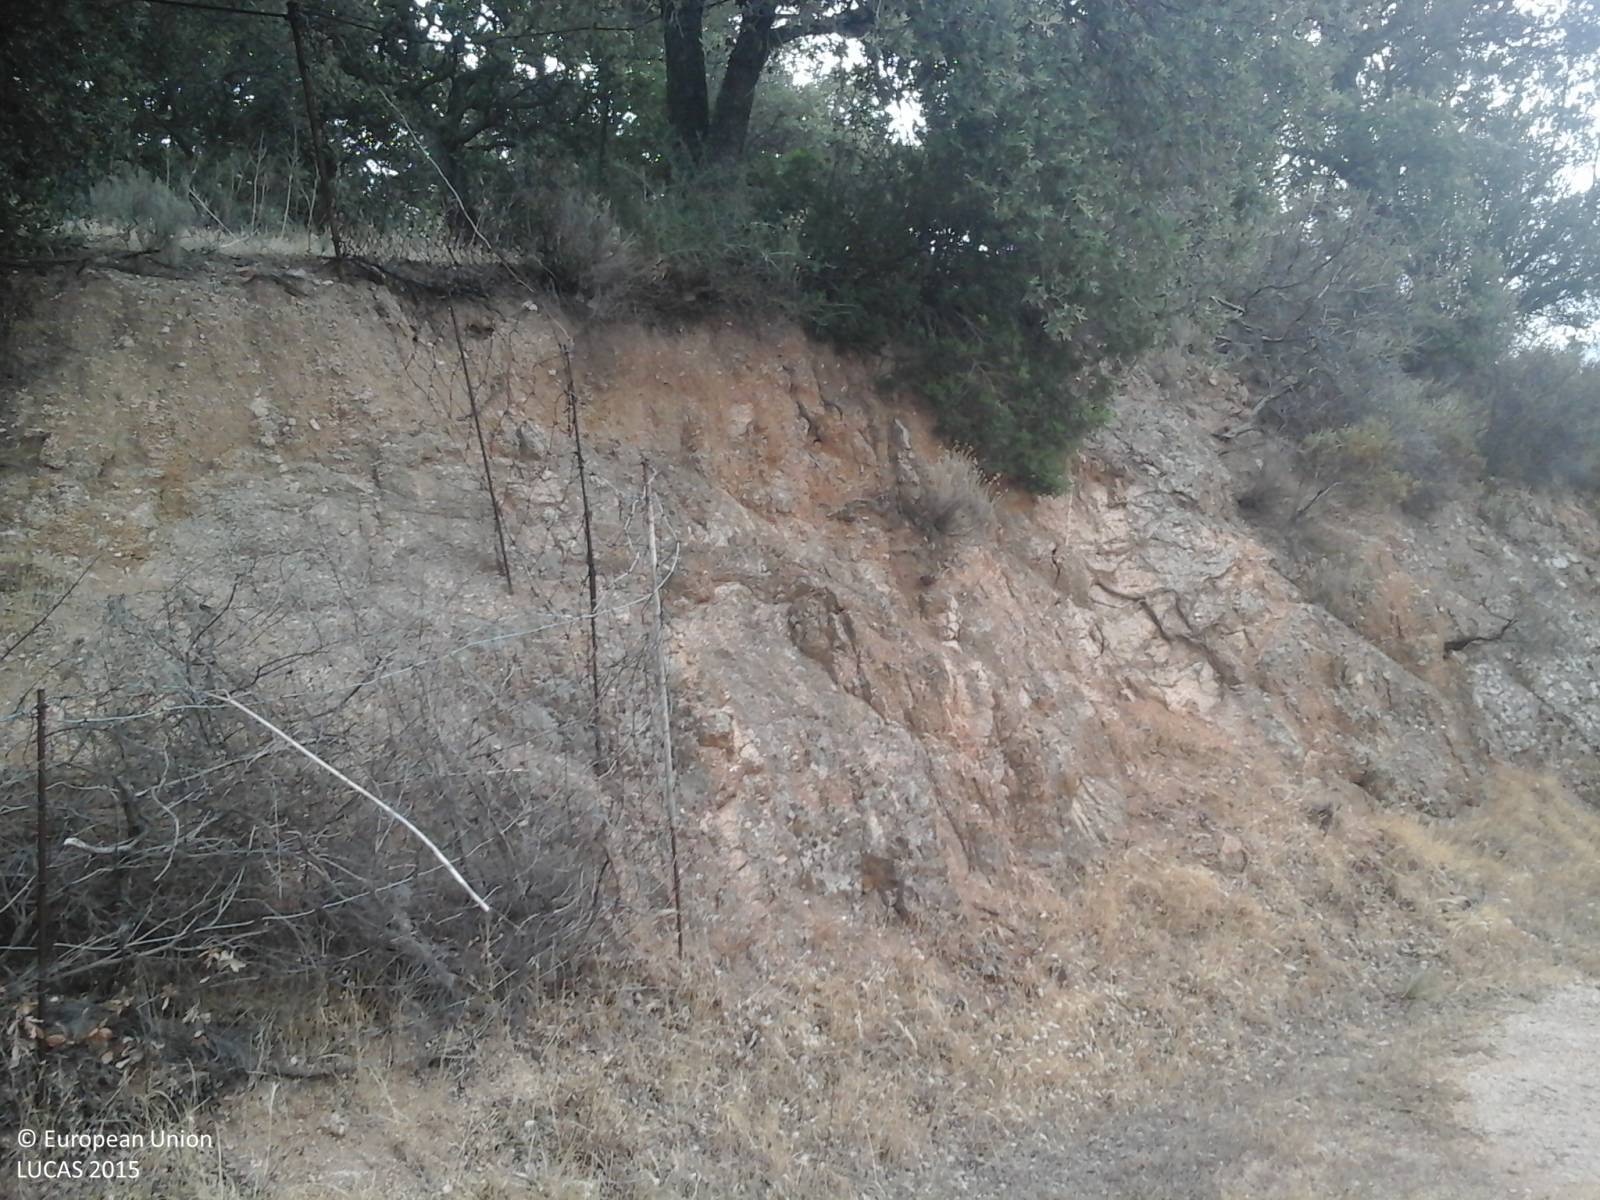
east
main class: Woodland
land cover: Broadleaved woodland
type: broadleaved evergreen forest
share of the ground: > 75 %
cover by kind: broadleaved forest trees 60 %, shrubs 25 %, herbaceous plants 10 %, unconsolidated bare surface 5 %
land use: Semi-natural and natural areas not in use
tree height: > 5 m
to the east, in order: Broadleaved woodland; Shrubland with sparse tree cover; Tracks; Broadleaved woodland; Tracks; Shrubland with sparse tree cover; Shrubland without tree cover
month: July
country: IT
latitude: 40.7906
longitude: 9.4457
